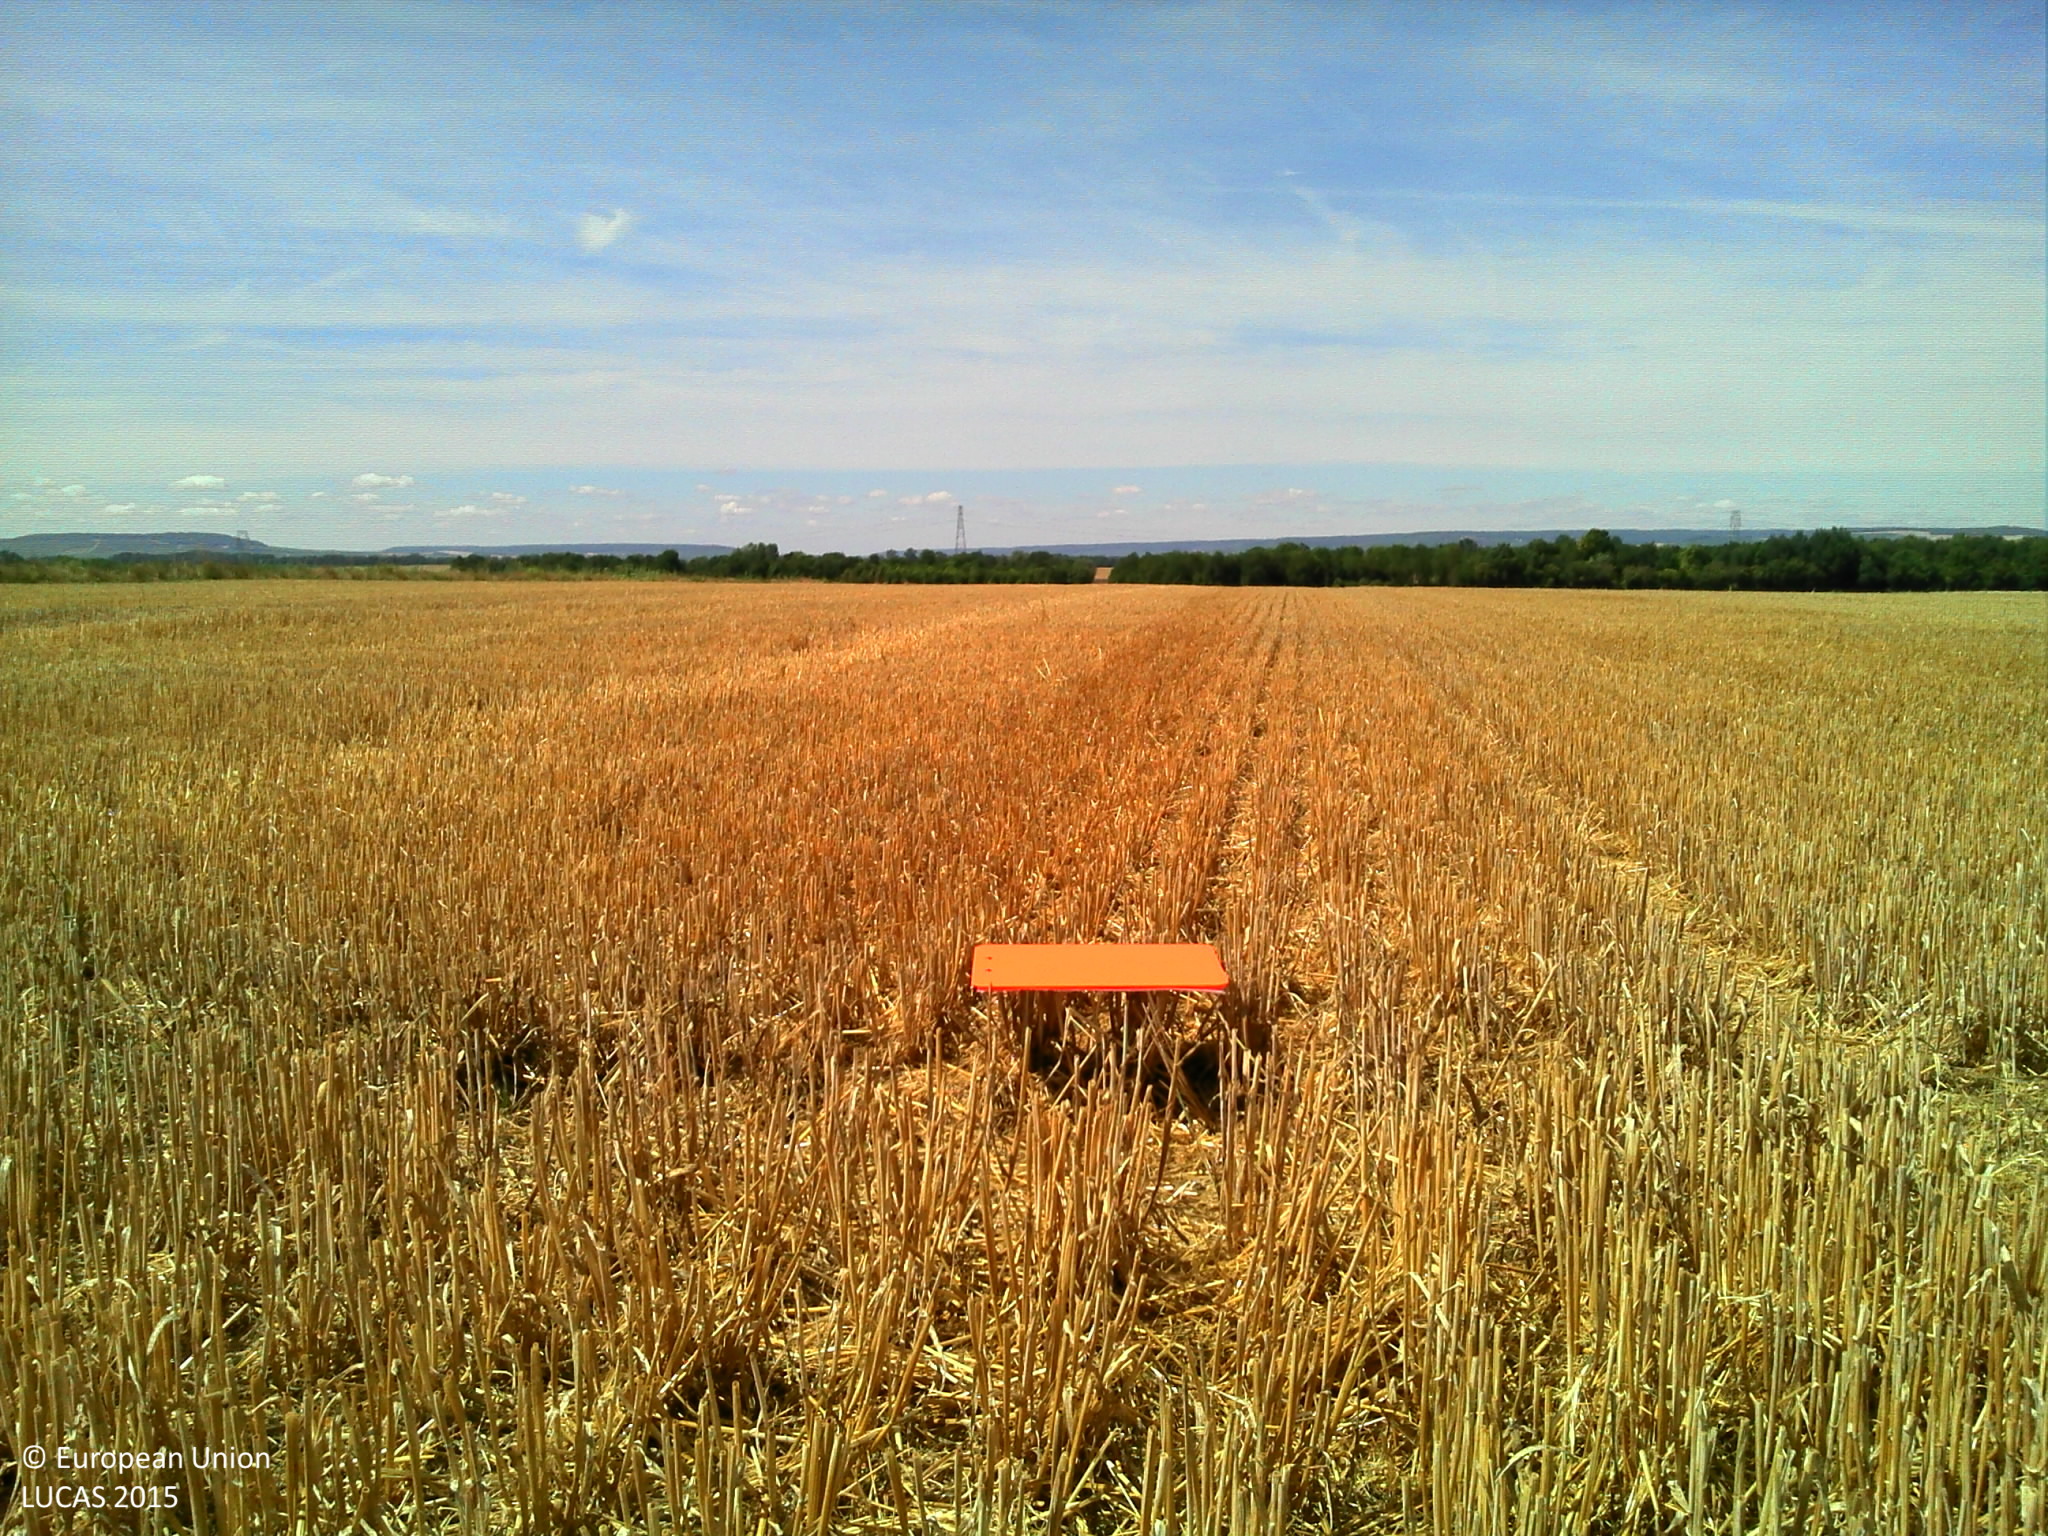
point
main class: Cropland
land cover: Barley
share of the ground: > 75 %
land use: Agriculture (excluding fallow land and kitchen gardens)
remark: Harvested field
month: August
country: FR
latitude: 48.9887
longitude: 4.1604
